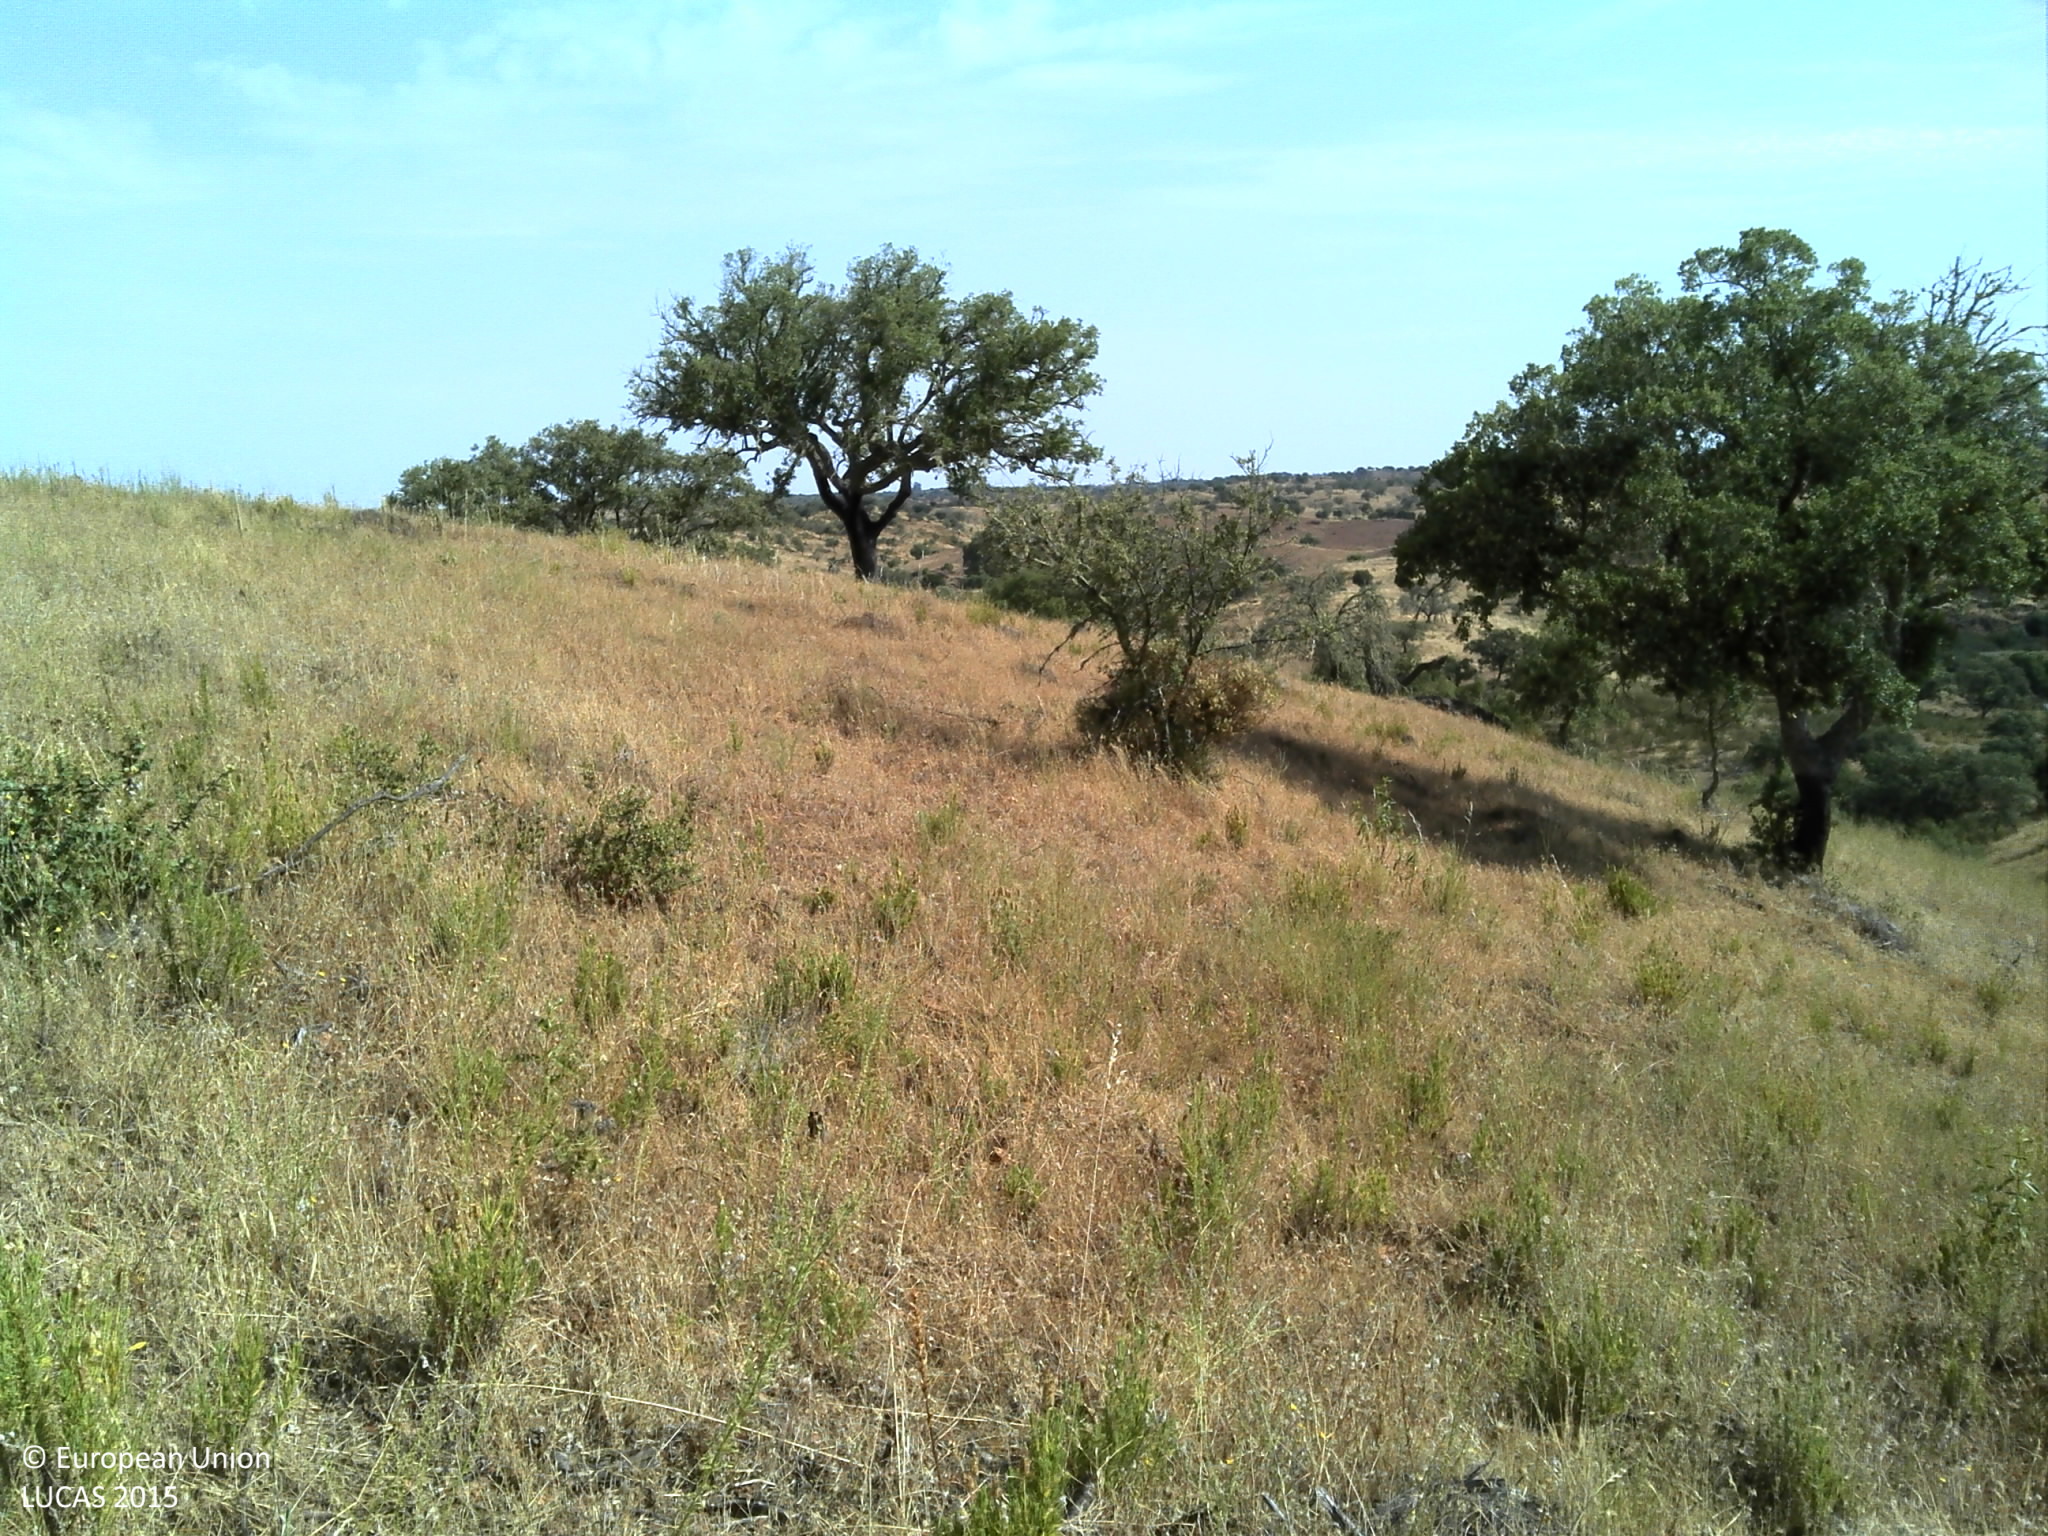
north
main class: Grassland
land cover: Grassland with sparse tree/shrub cover
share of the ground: 50 - 75 %
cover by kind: herbaceous plants 95 %, broadleaved forest trees 5 %
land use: Agriculture (excluding fallow land and kitchen gardens)
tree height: < 5 m
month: June
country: PT
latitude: 37.7776
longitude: -7.4879
